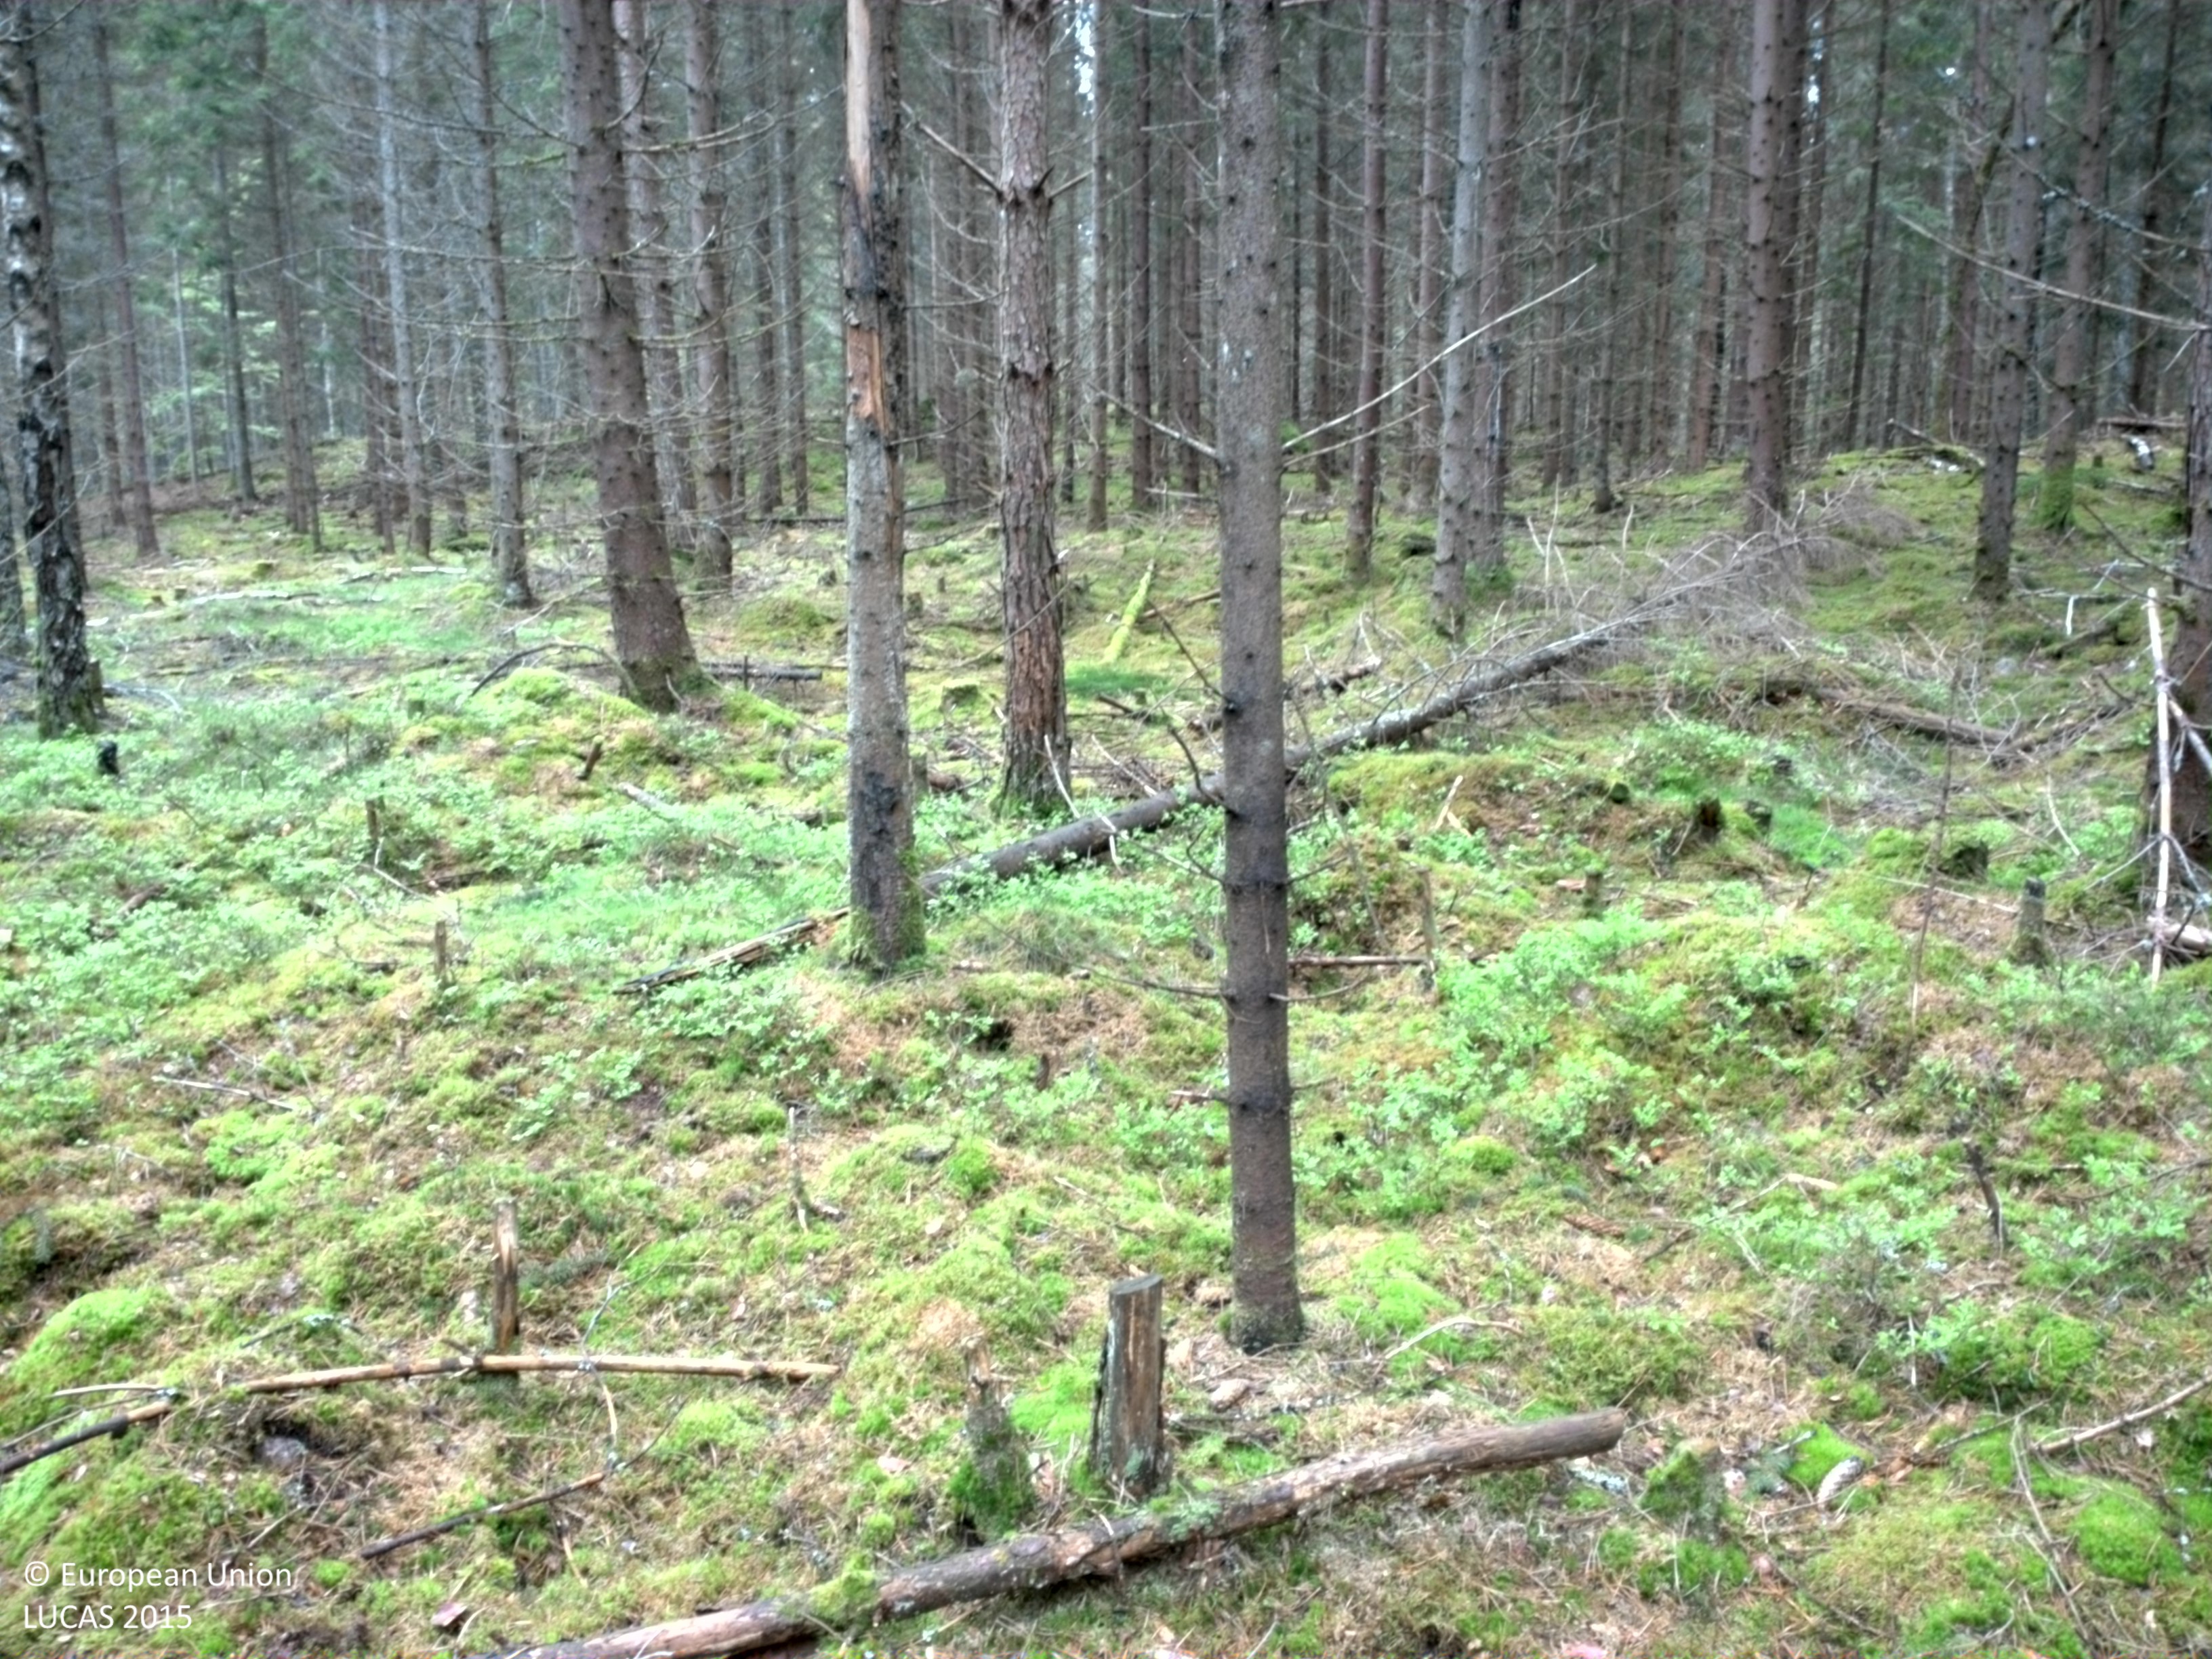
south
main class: Woodland
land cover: Spruce dominated coniferous woodland
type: boreal forest
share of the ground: > 75 %
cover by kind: coniferous forest trees 85 %, broadleaved forest trees 10 %, lichens and mosses 5 %
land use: Forestry
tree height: > 5 m
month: May
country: SE
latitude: 56.5394
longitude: 15.4793
